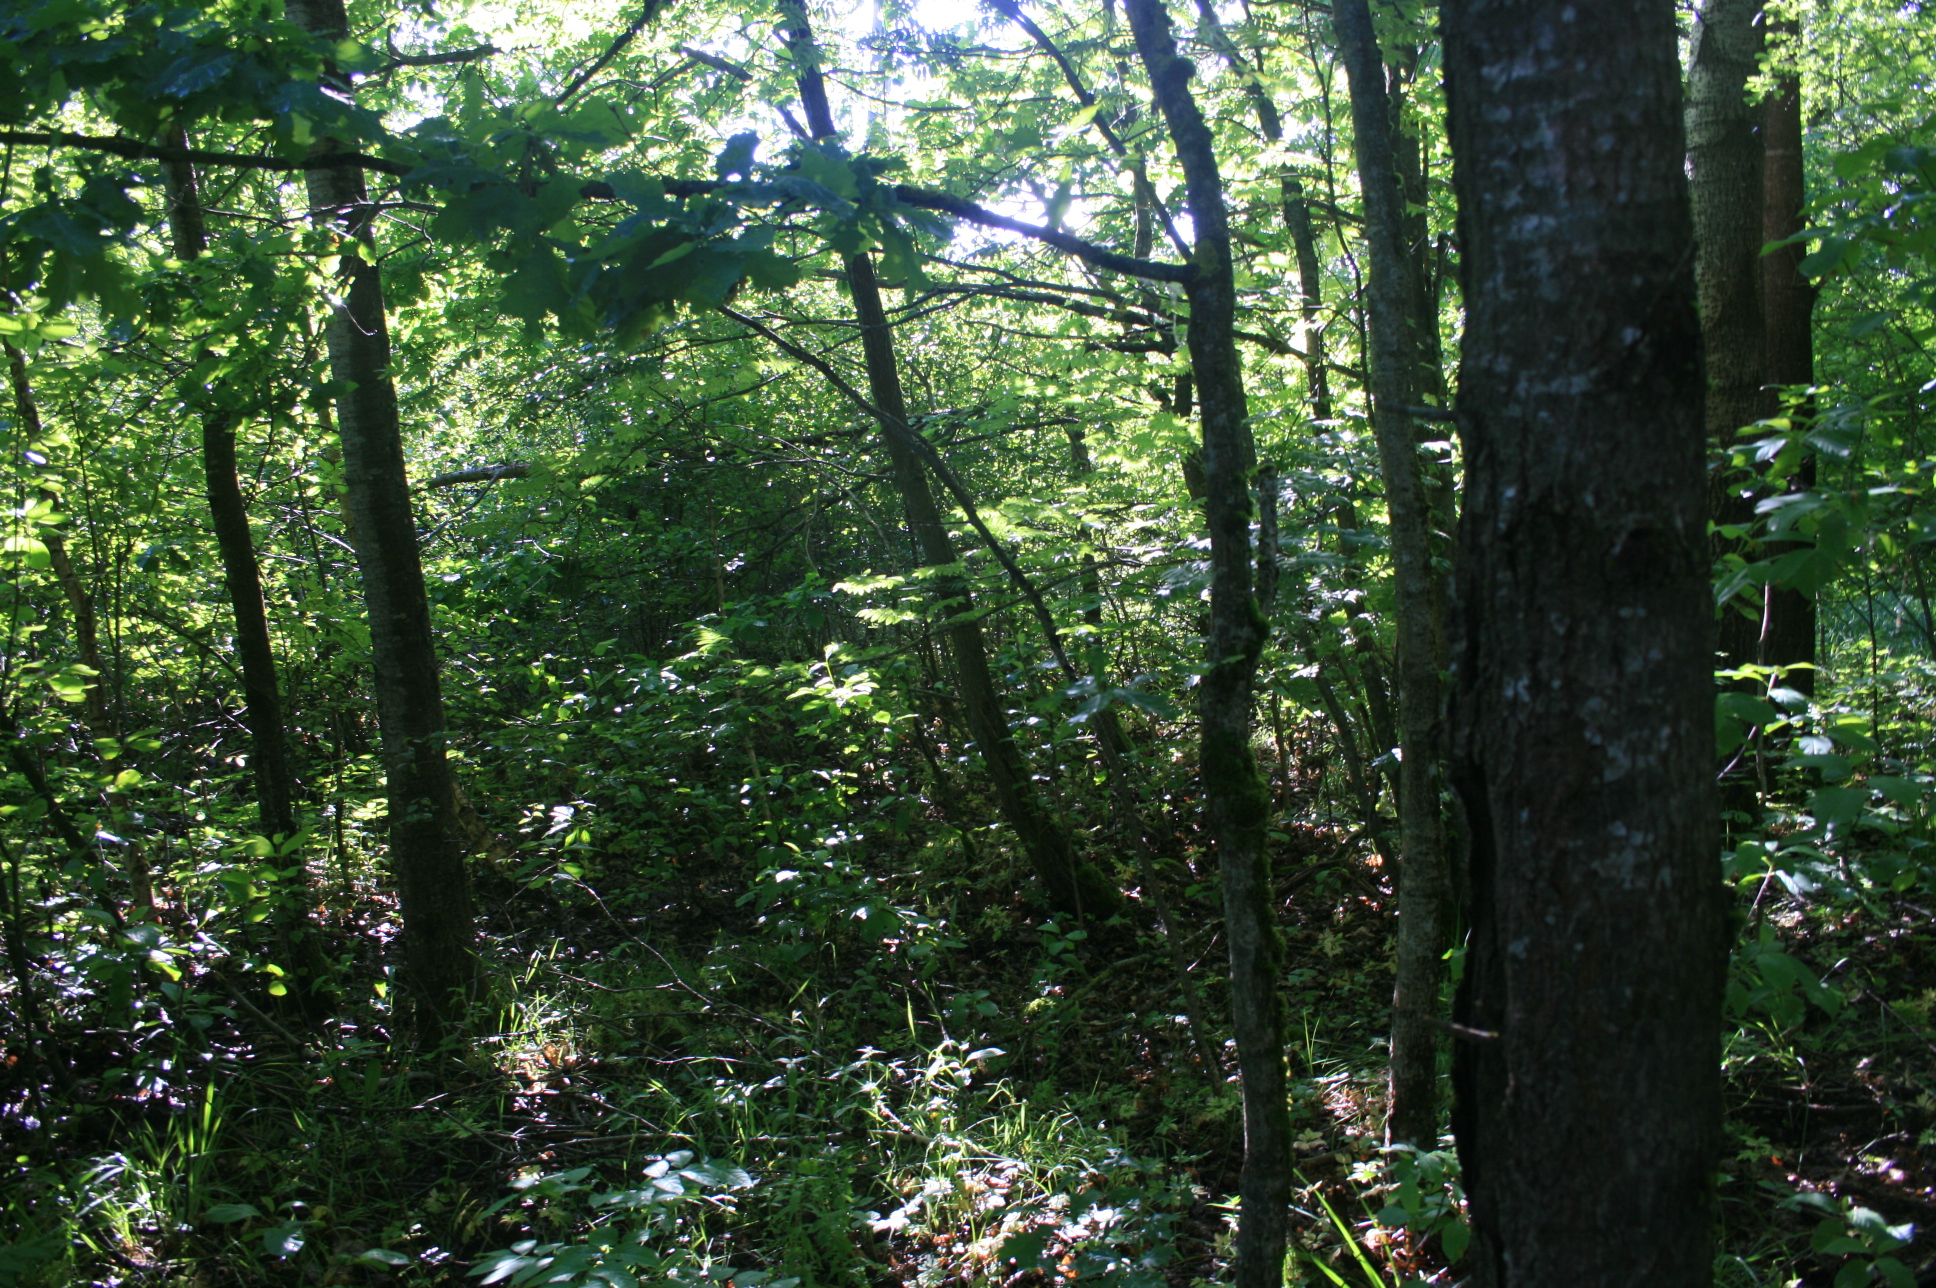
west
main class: Woodland
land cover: Broadleaved woodland
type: non-riverine alder, birch or aspen forest
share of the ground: > 75 %
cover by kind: broadleaved forest trees 95 %, herbaceous plants 5 %
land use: Forestry
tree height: > 5 m
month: June
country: LT
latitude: 55.5031
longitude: 22.1028
